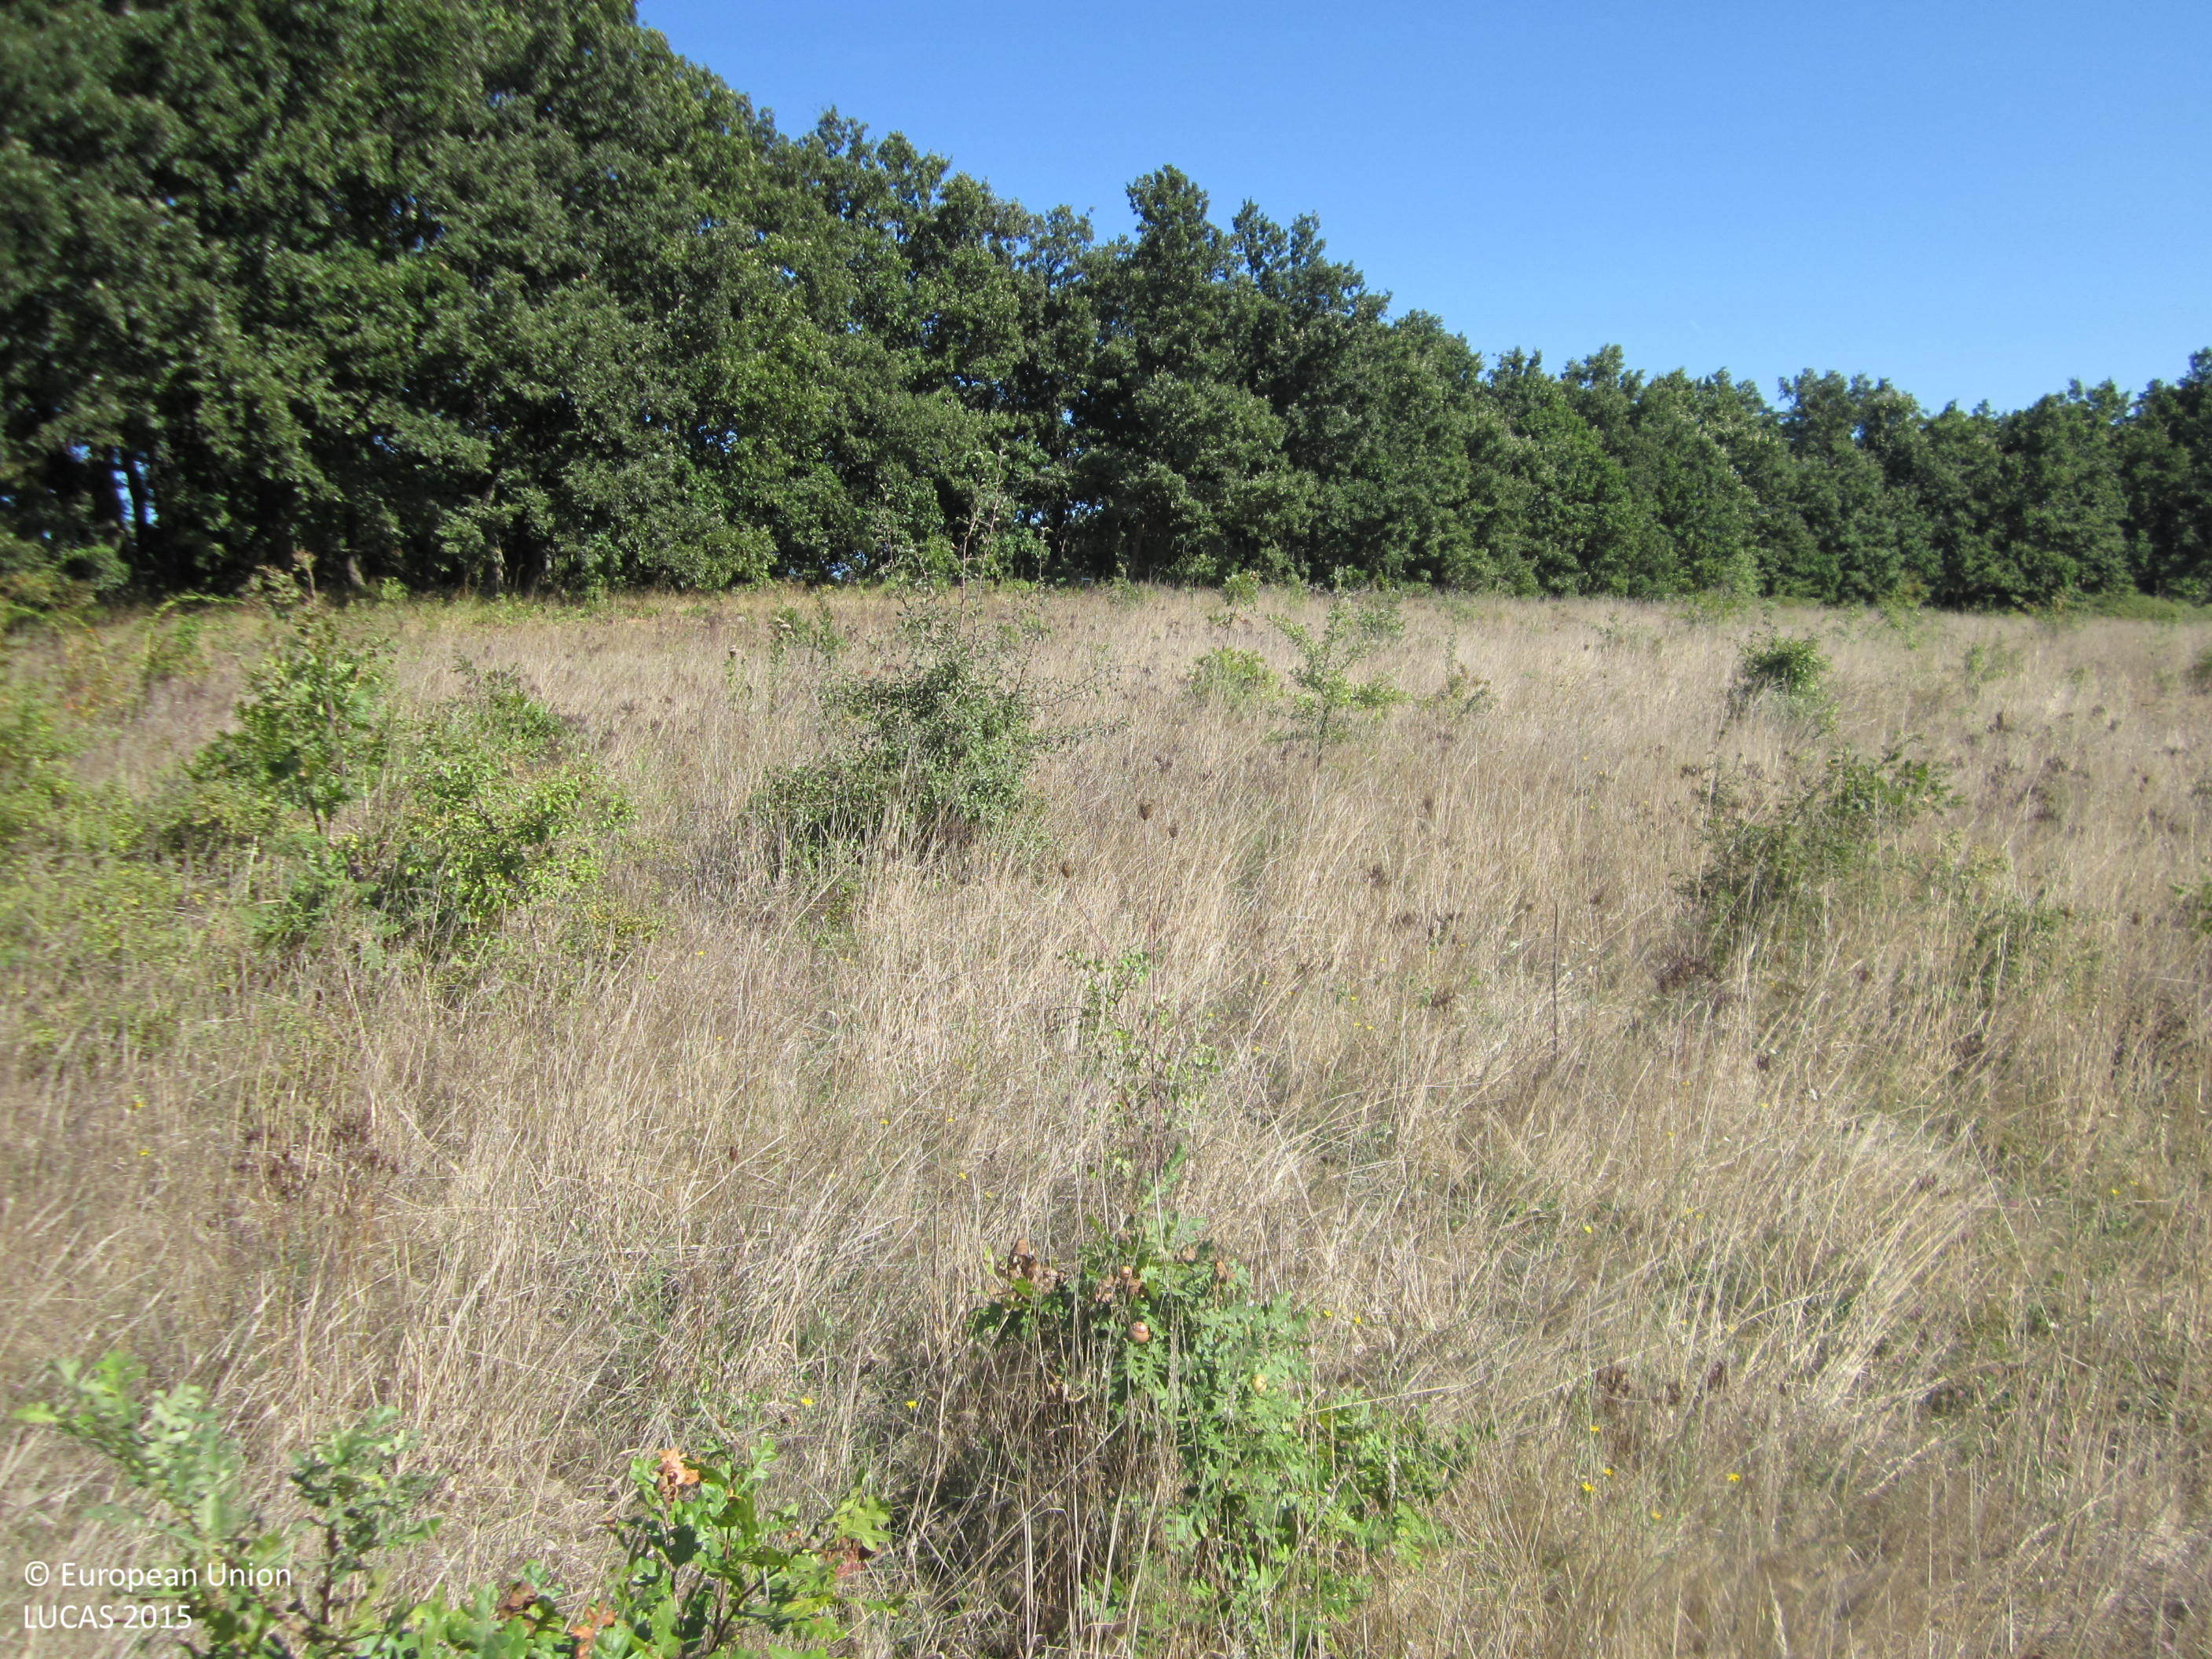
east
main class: Grassland
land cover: Grassland with sparse tree/shrub cover
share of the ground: > 75 %
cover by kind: herbaceous plants 85 %, shrubs 10 %, broadleaved forest trees 5 %
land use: Agriculture (excluding fallow land and kitchen gardens)
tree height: > 5 m
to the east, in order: Grassland with sparse tree/shrub cover; Broadleaved woodland; Tracks; Shrubland with sparse tree cover; Broadleaved woodland; Grassland without tree/shrub cover
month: September
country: BG
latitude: 42.1039
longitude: 27.0171
